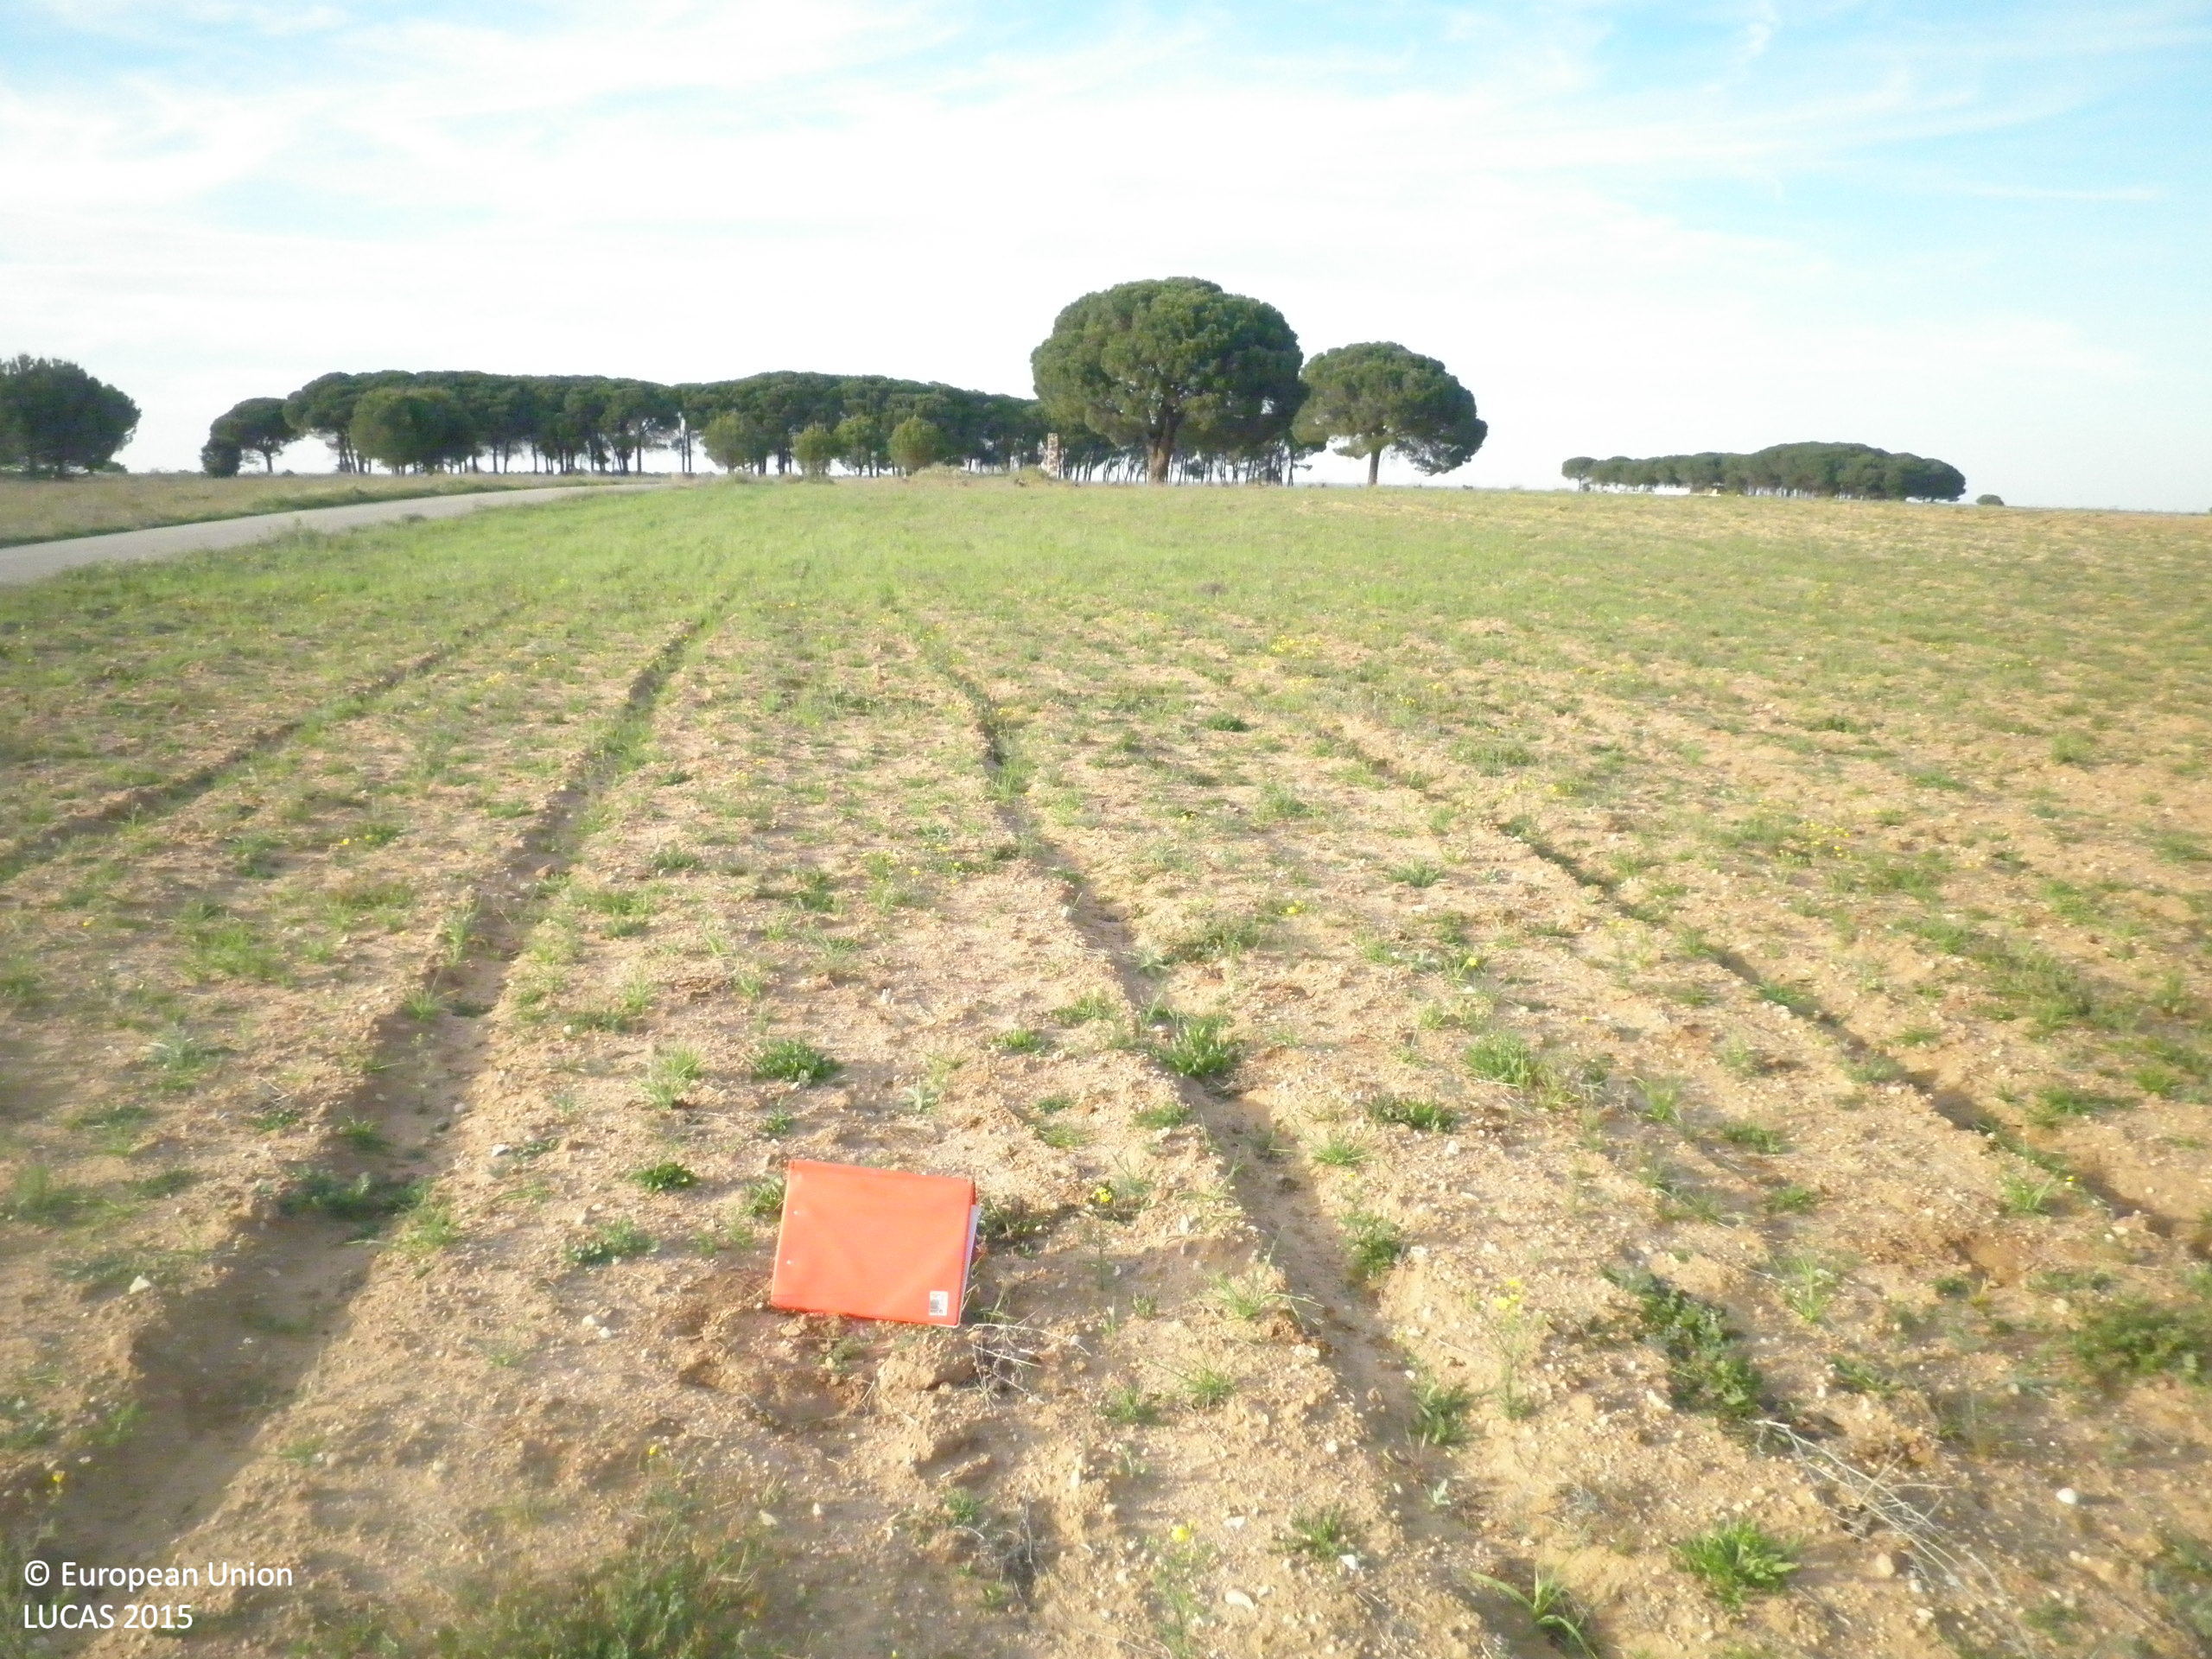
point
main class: Grassland
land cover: Spontaneously vegetated surfaces
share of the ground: 10 - 25 %
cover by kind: unconsolidated bare surface 75 %, herbaceous plants 25 %
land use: Fallow land
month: April
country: ES
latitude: 39.3385
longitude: -2.7633
